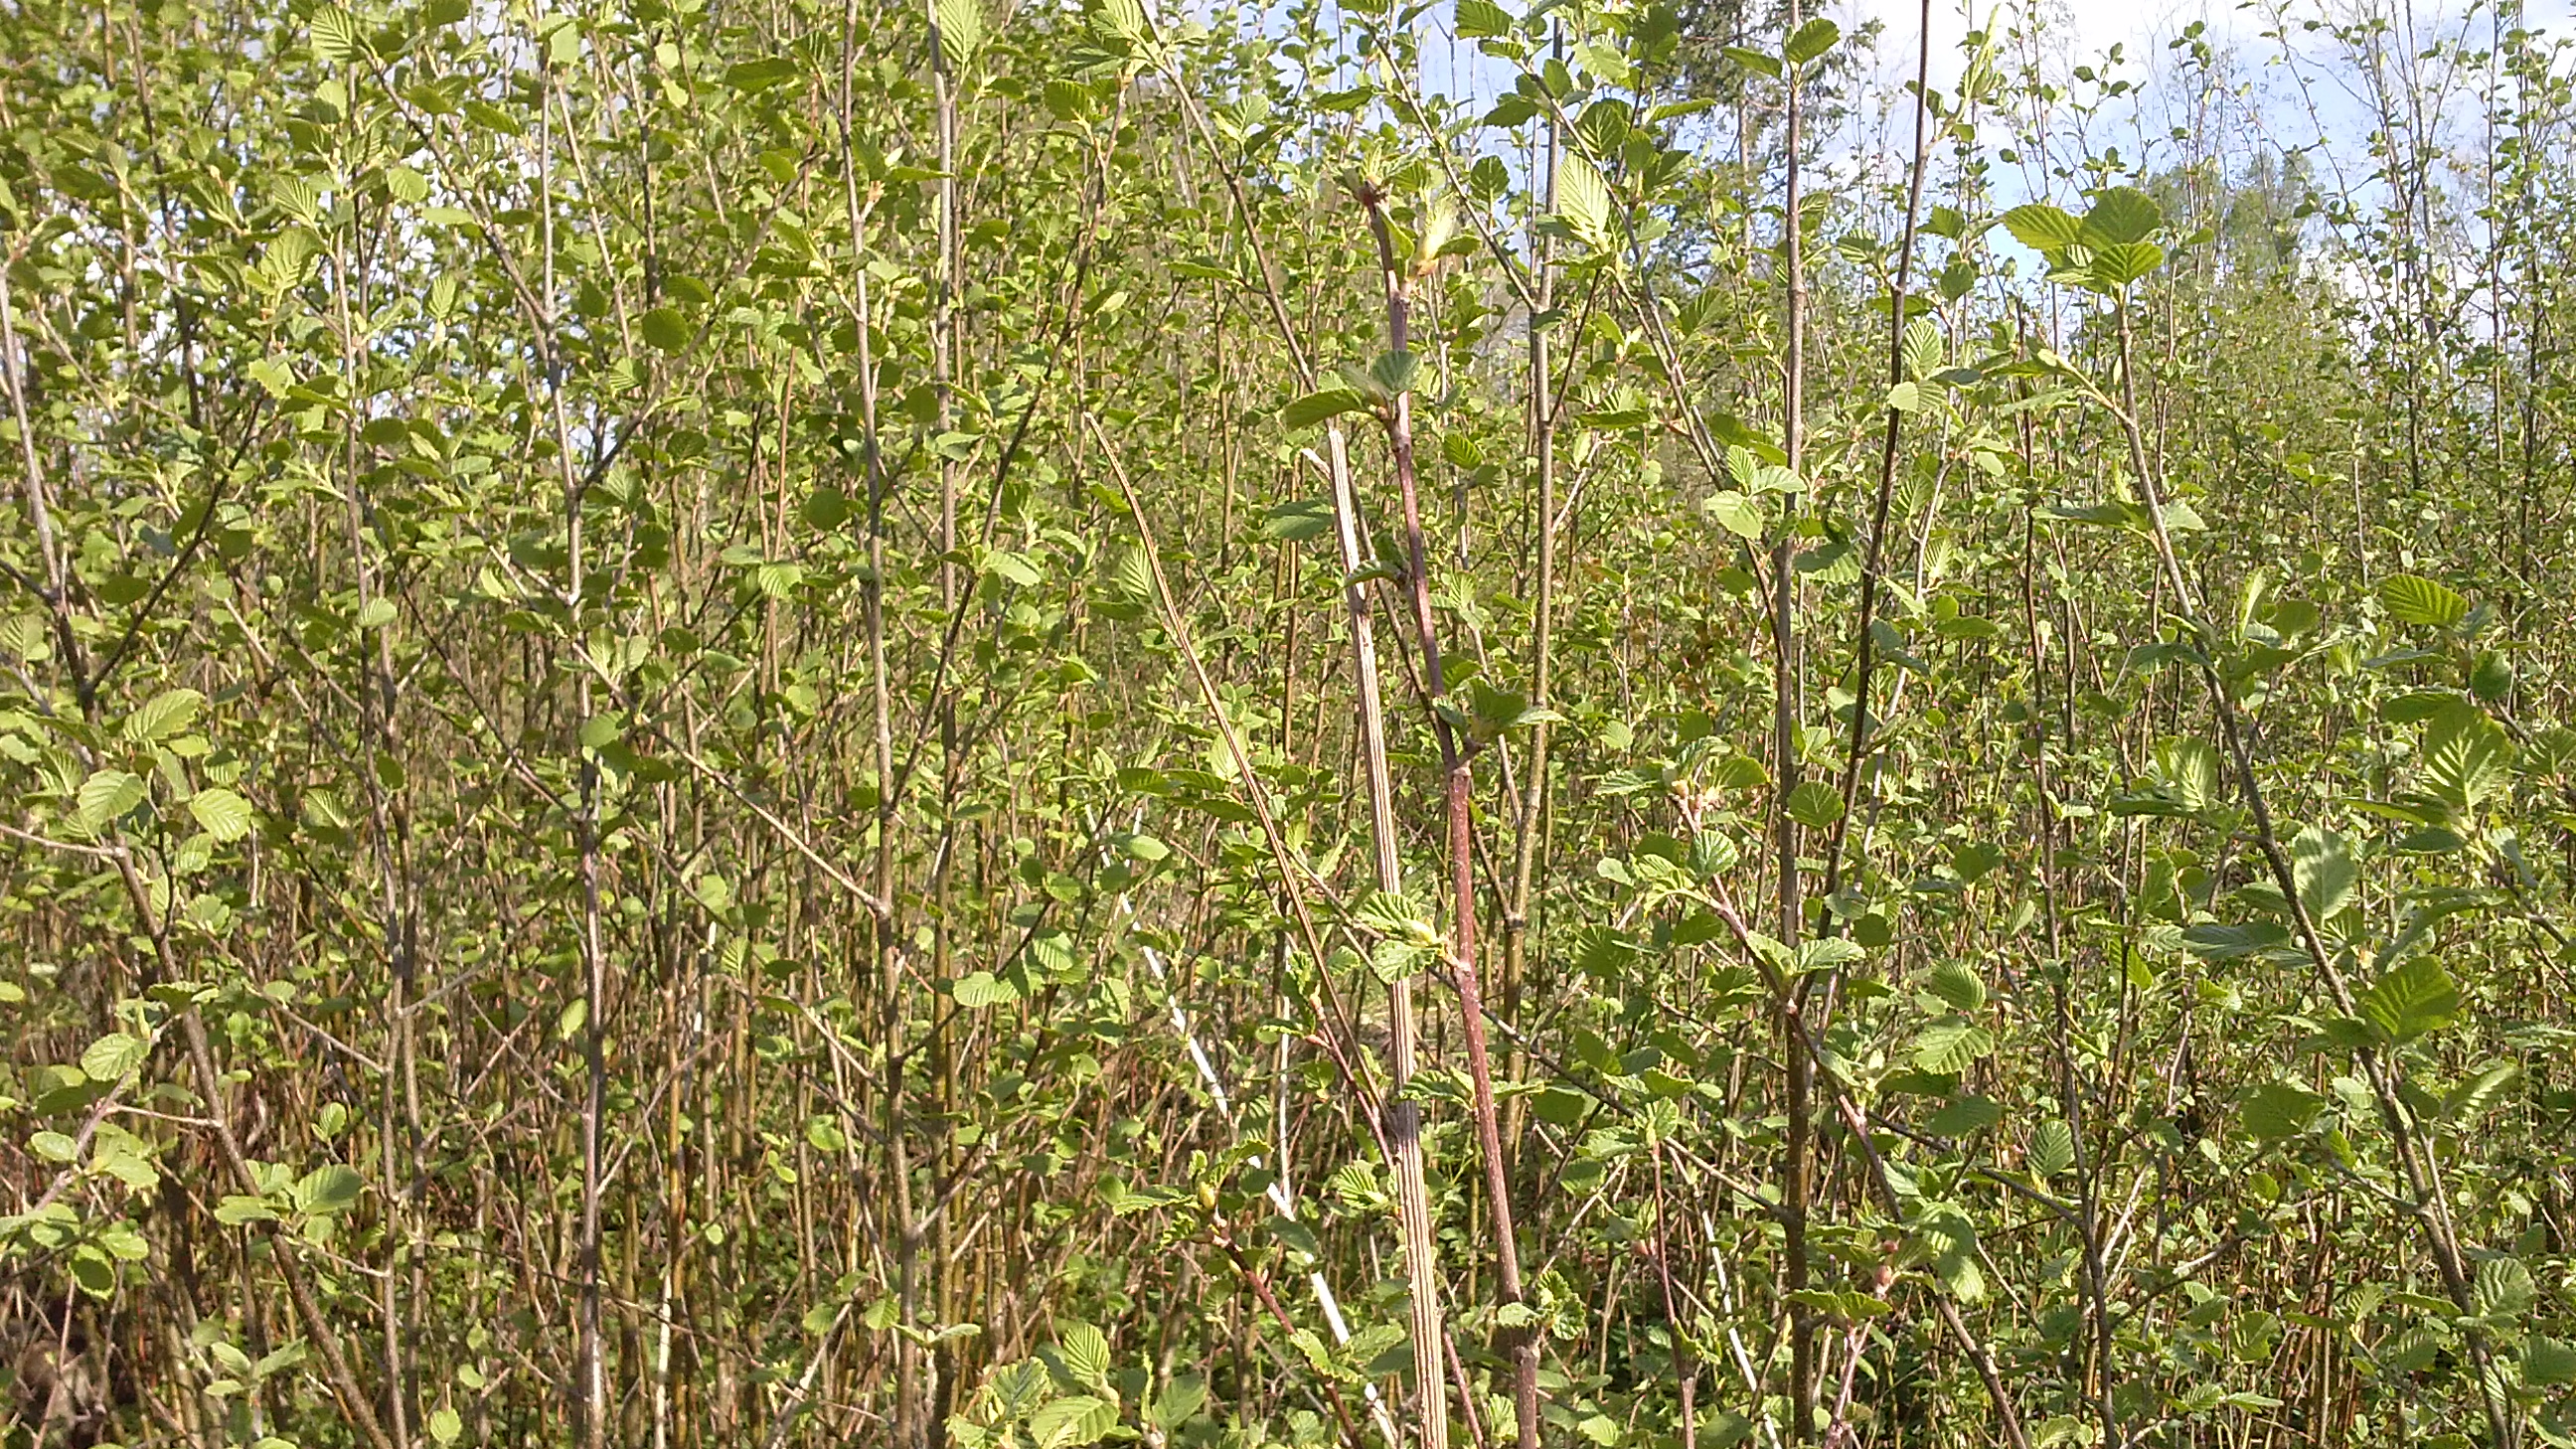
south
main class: Woodland
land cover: Broadleaved woodland
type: non-riverine alder, birch or aspen forest
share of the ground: > 75 %
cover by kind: broadleaved forest trees 100 %
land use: Forestry
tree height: > 5 m
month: May
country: LV
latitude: 56.1056
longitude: 27.6975
